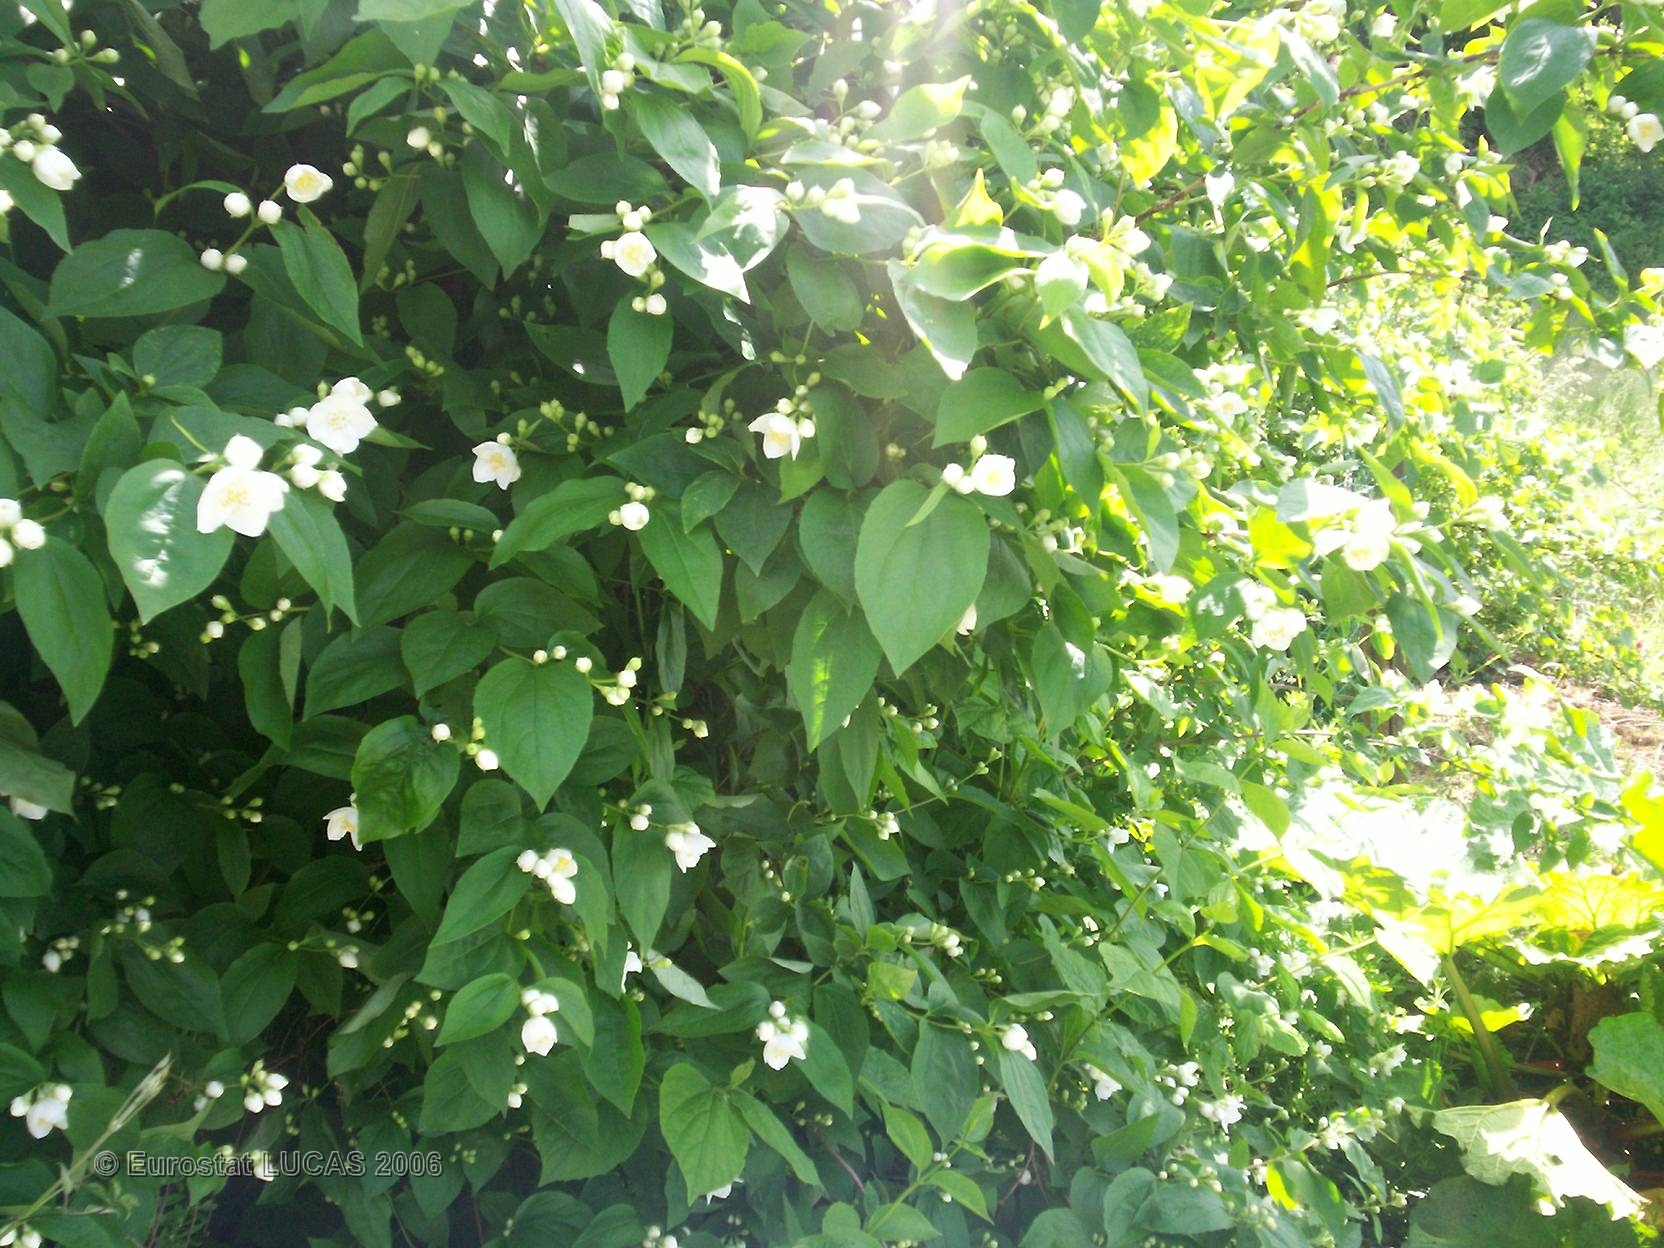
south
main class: Cropland
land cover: Other fresh vegetables
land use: Kitchen garden
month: June
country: FR
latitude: 49.2486
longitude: 5.0661
